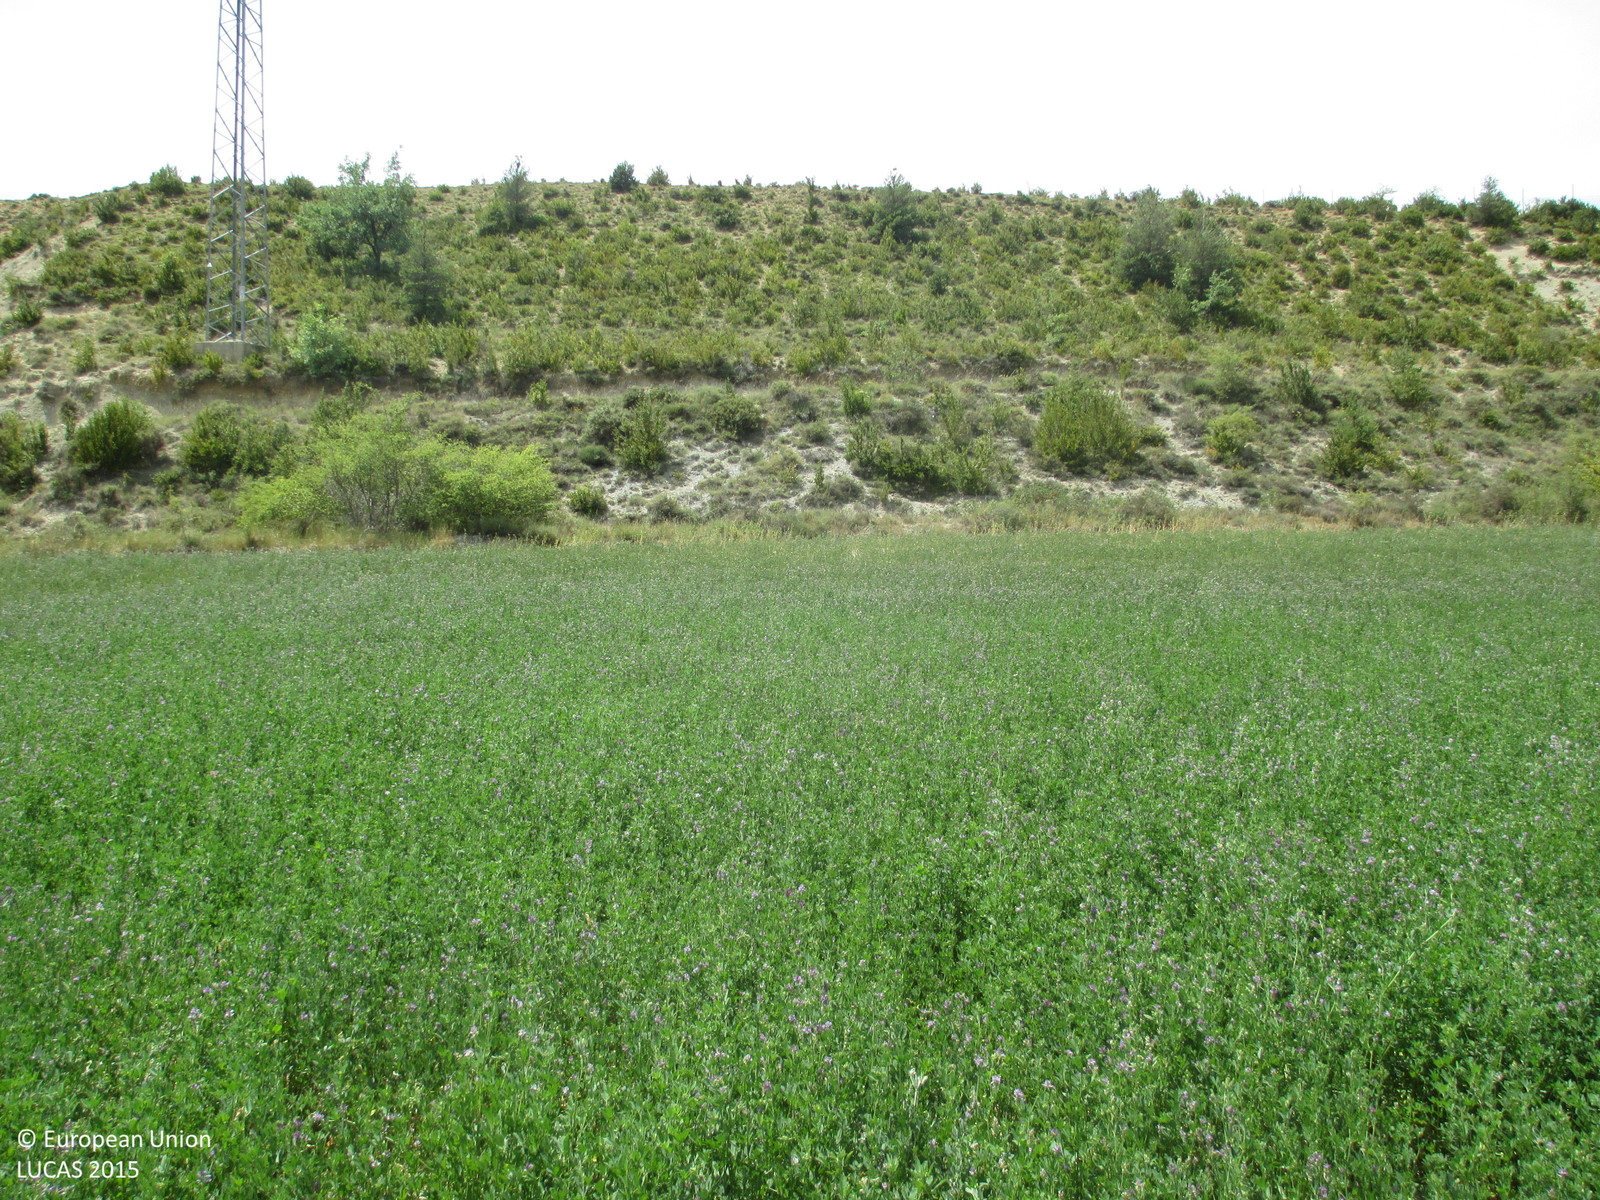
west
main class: Cropland
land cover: Lucerne
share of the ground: > 75 %
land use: Agriculture (excluding fallow land and kitchen gardens)
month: July
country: ES
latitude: 42.5370
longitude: -0.3872
